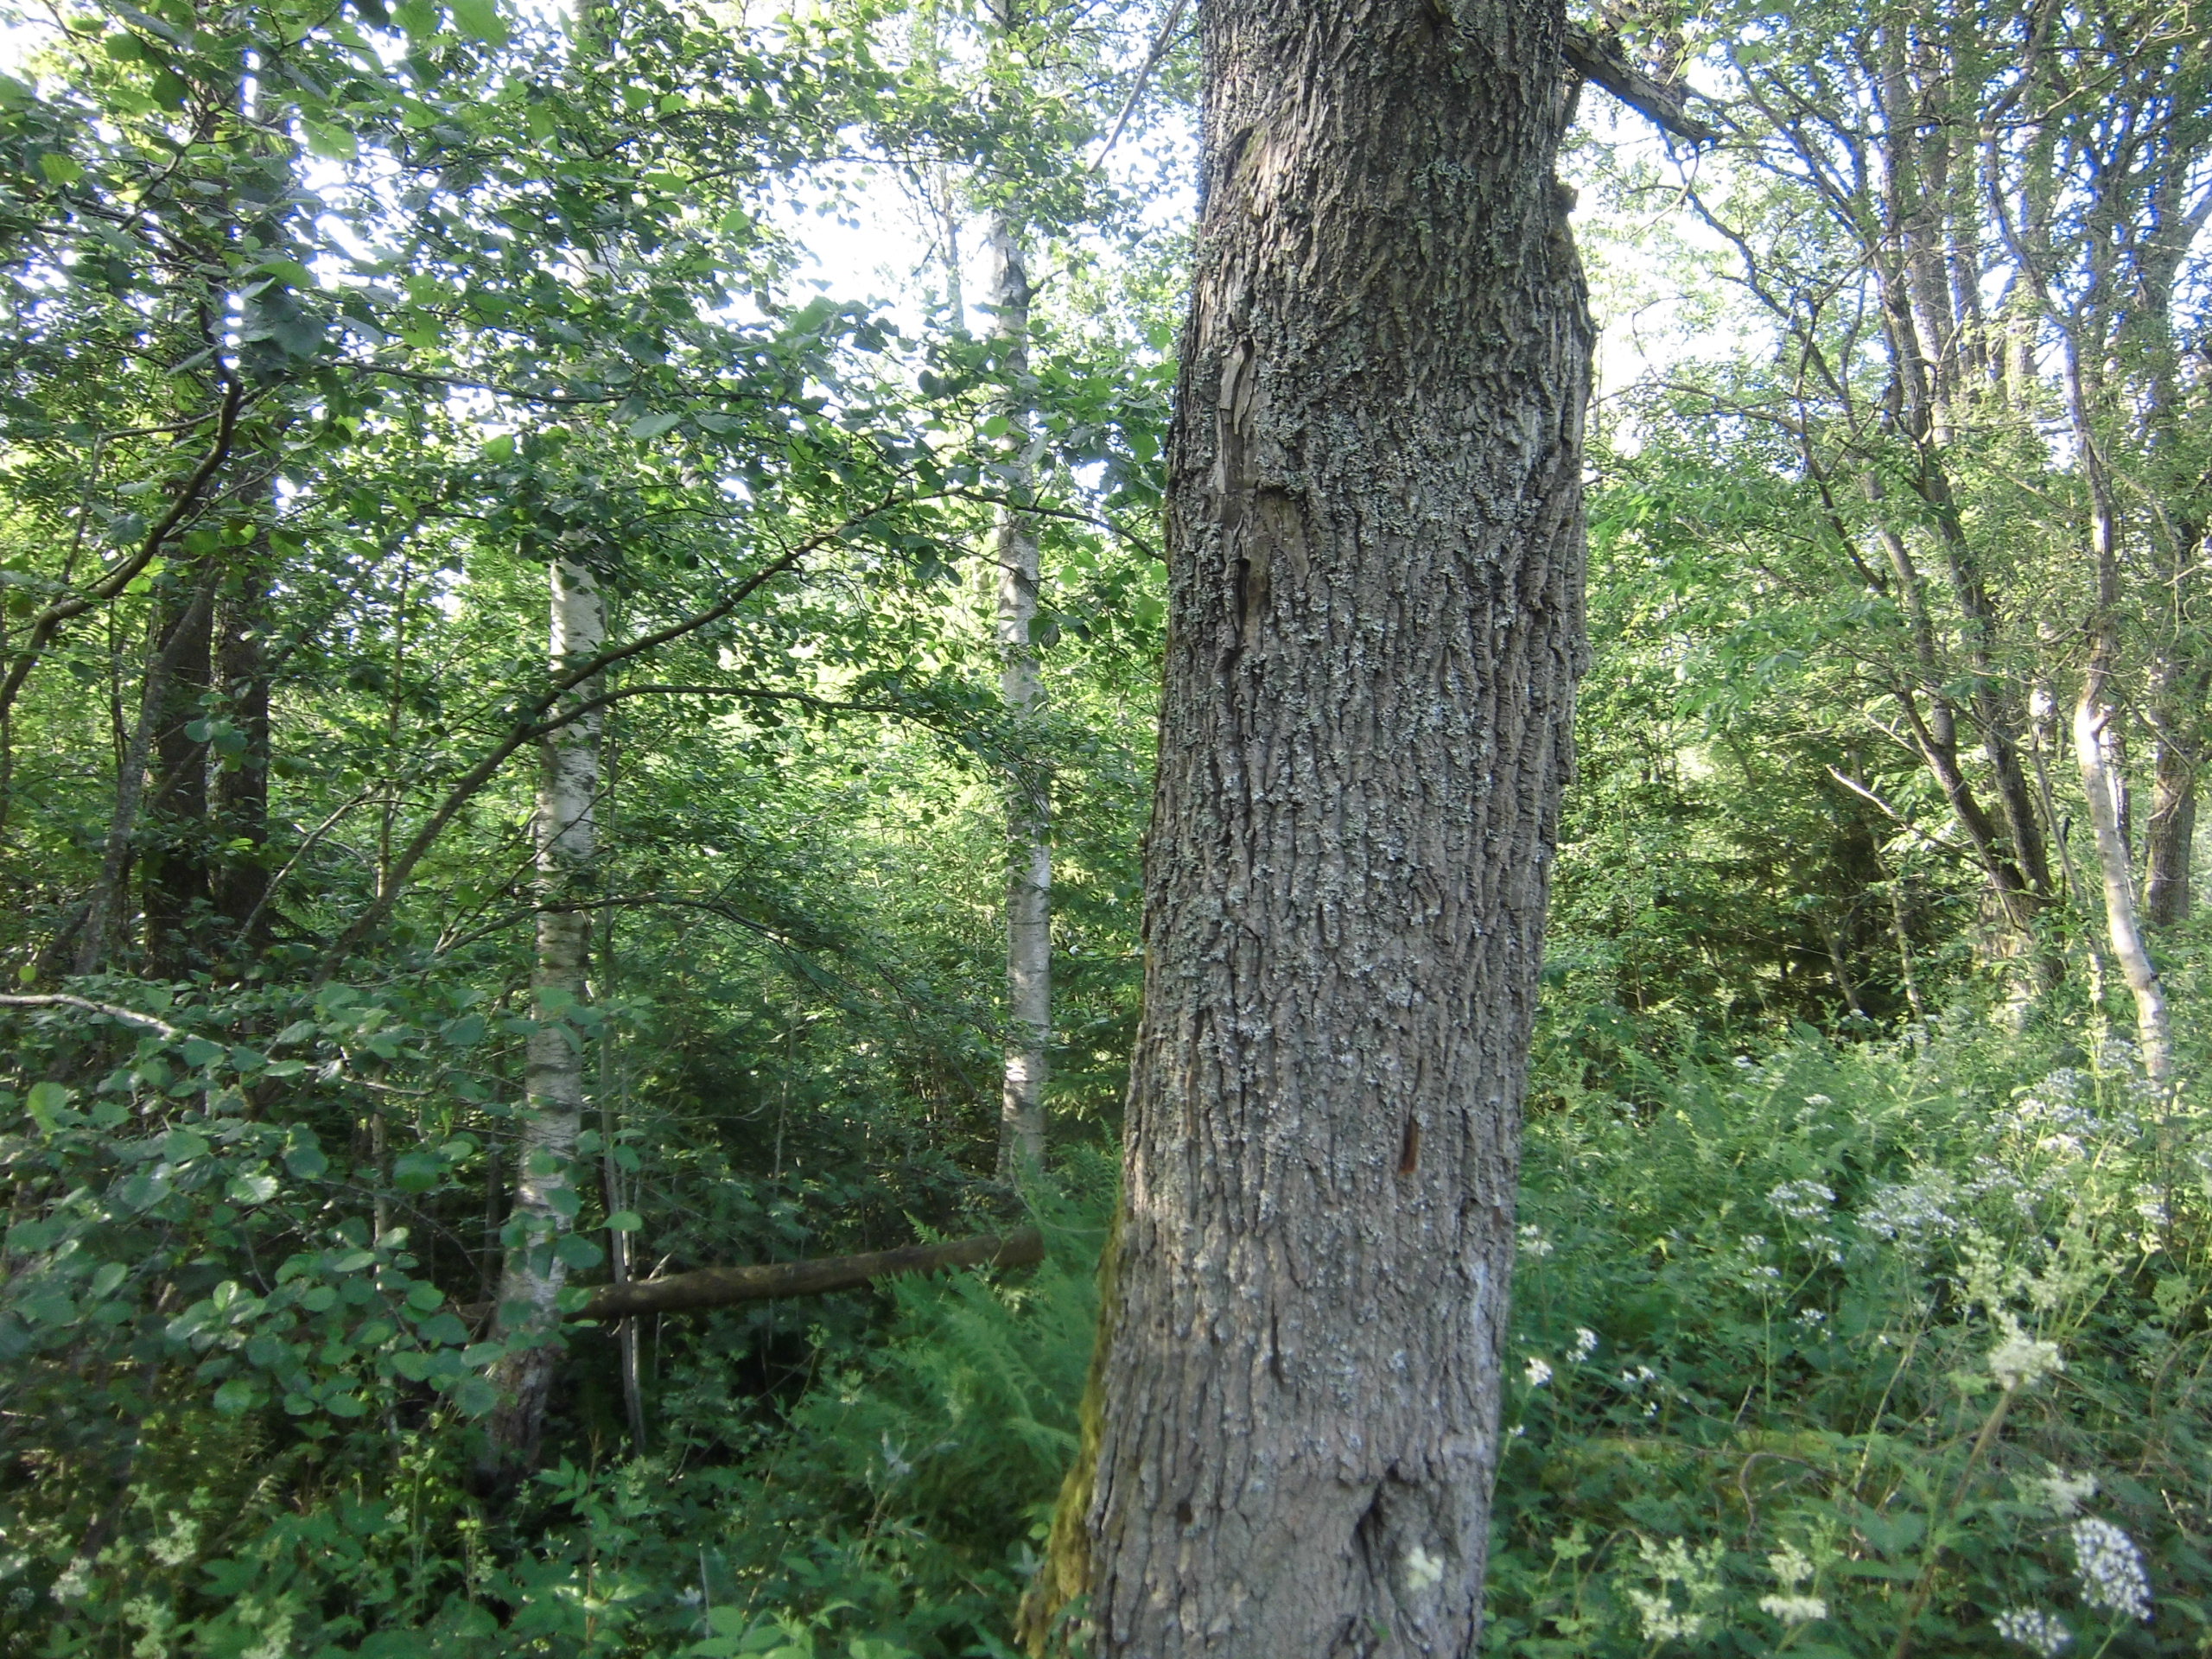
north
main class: Woodland
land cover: Broadleaved woodland
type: boreal forest
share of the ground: 50 - 75 %
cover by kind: broadleaved forest trees 60 %, herbaceous plants 35 %, shrubs 5 %
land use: Forestry
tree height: > 5 m
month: July
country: SE
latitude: 57.3824
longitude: 15.1363
